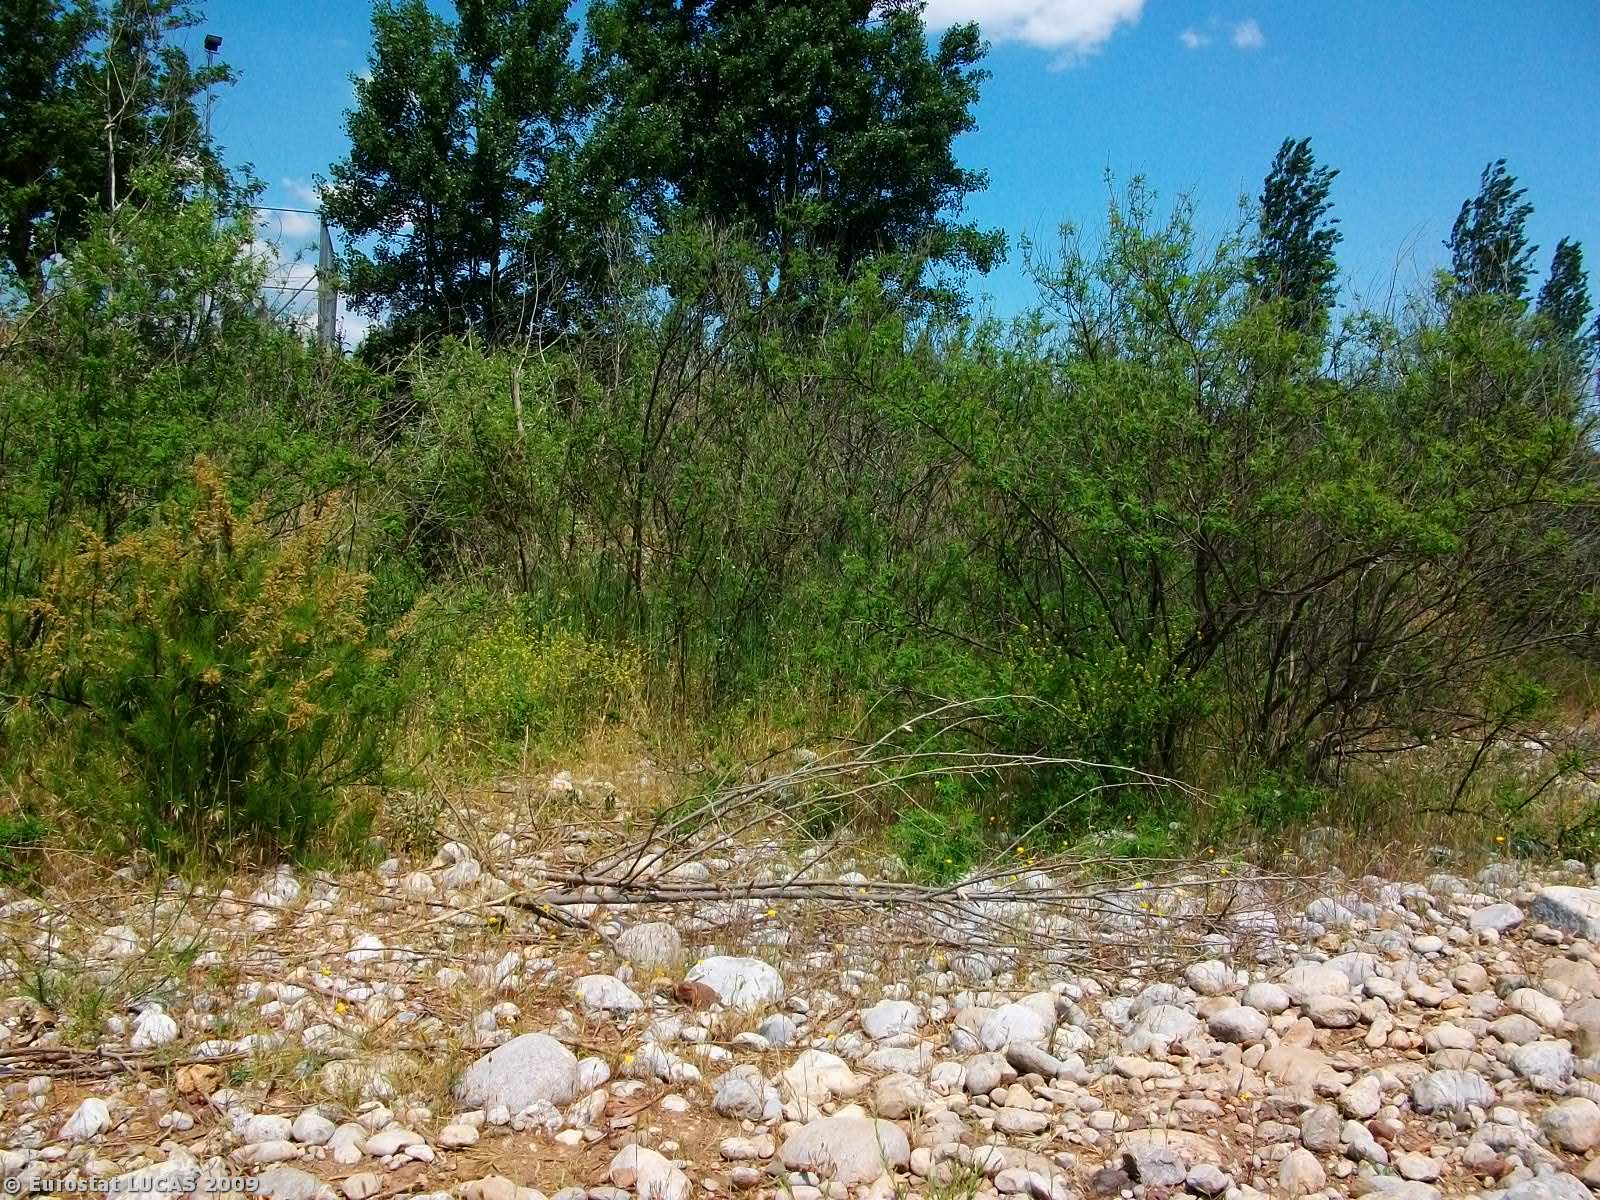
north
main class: Bare land
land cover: Bare land
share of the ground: > 75 %
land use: Unused
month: May
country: GR
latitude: 39.1750
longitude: 22.7546
